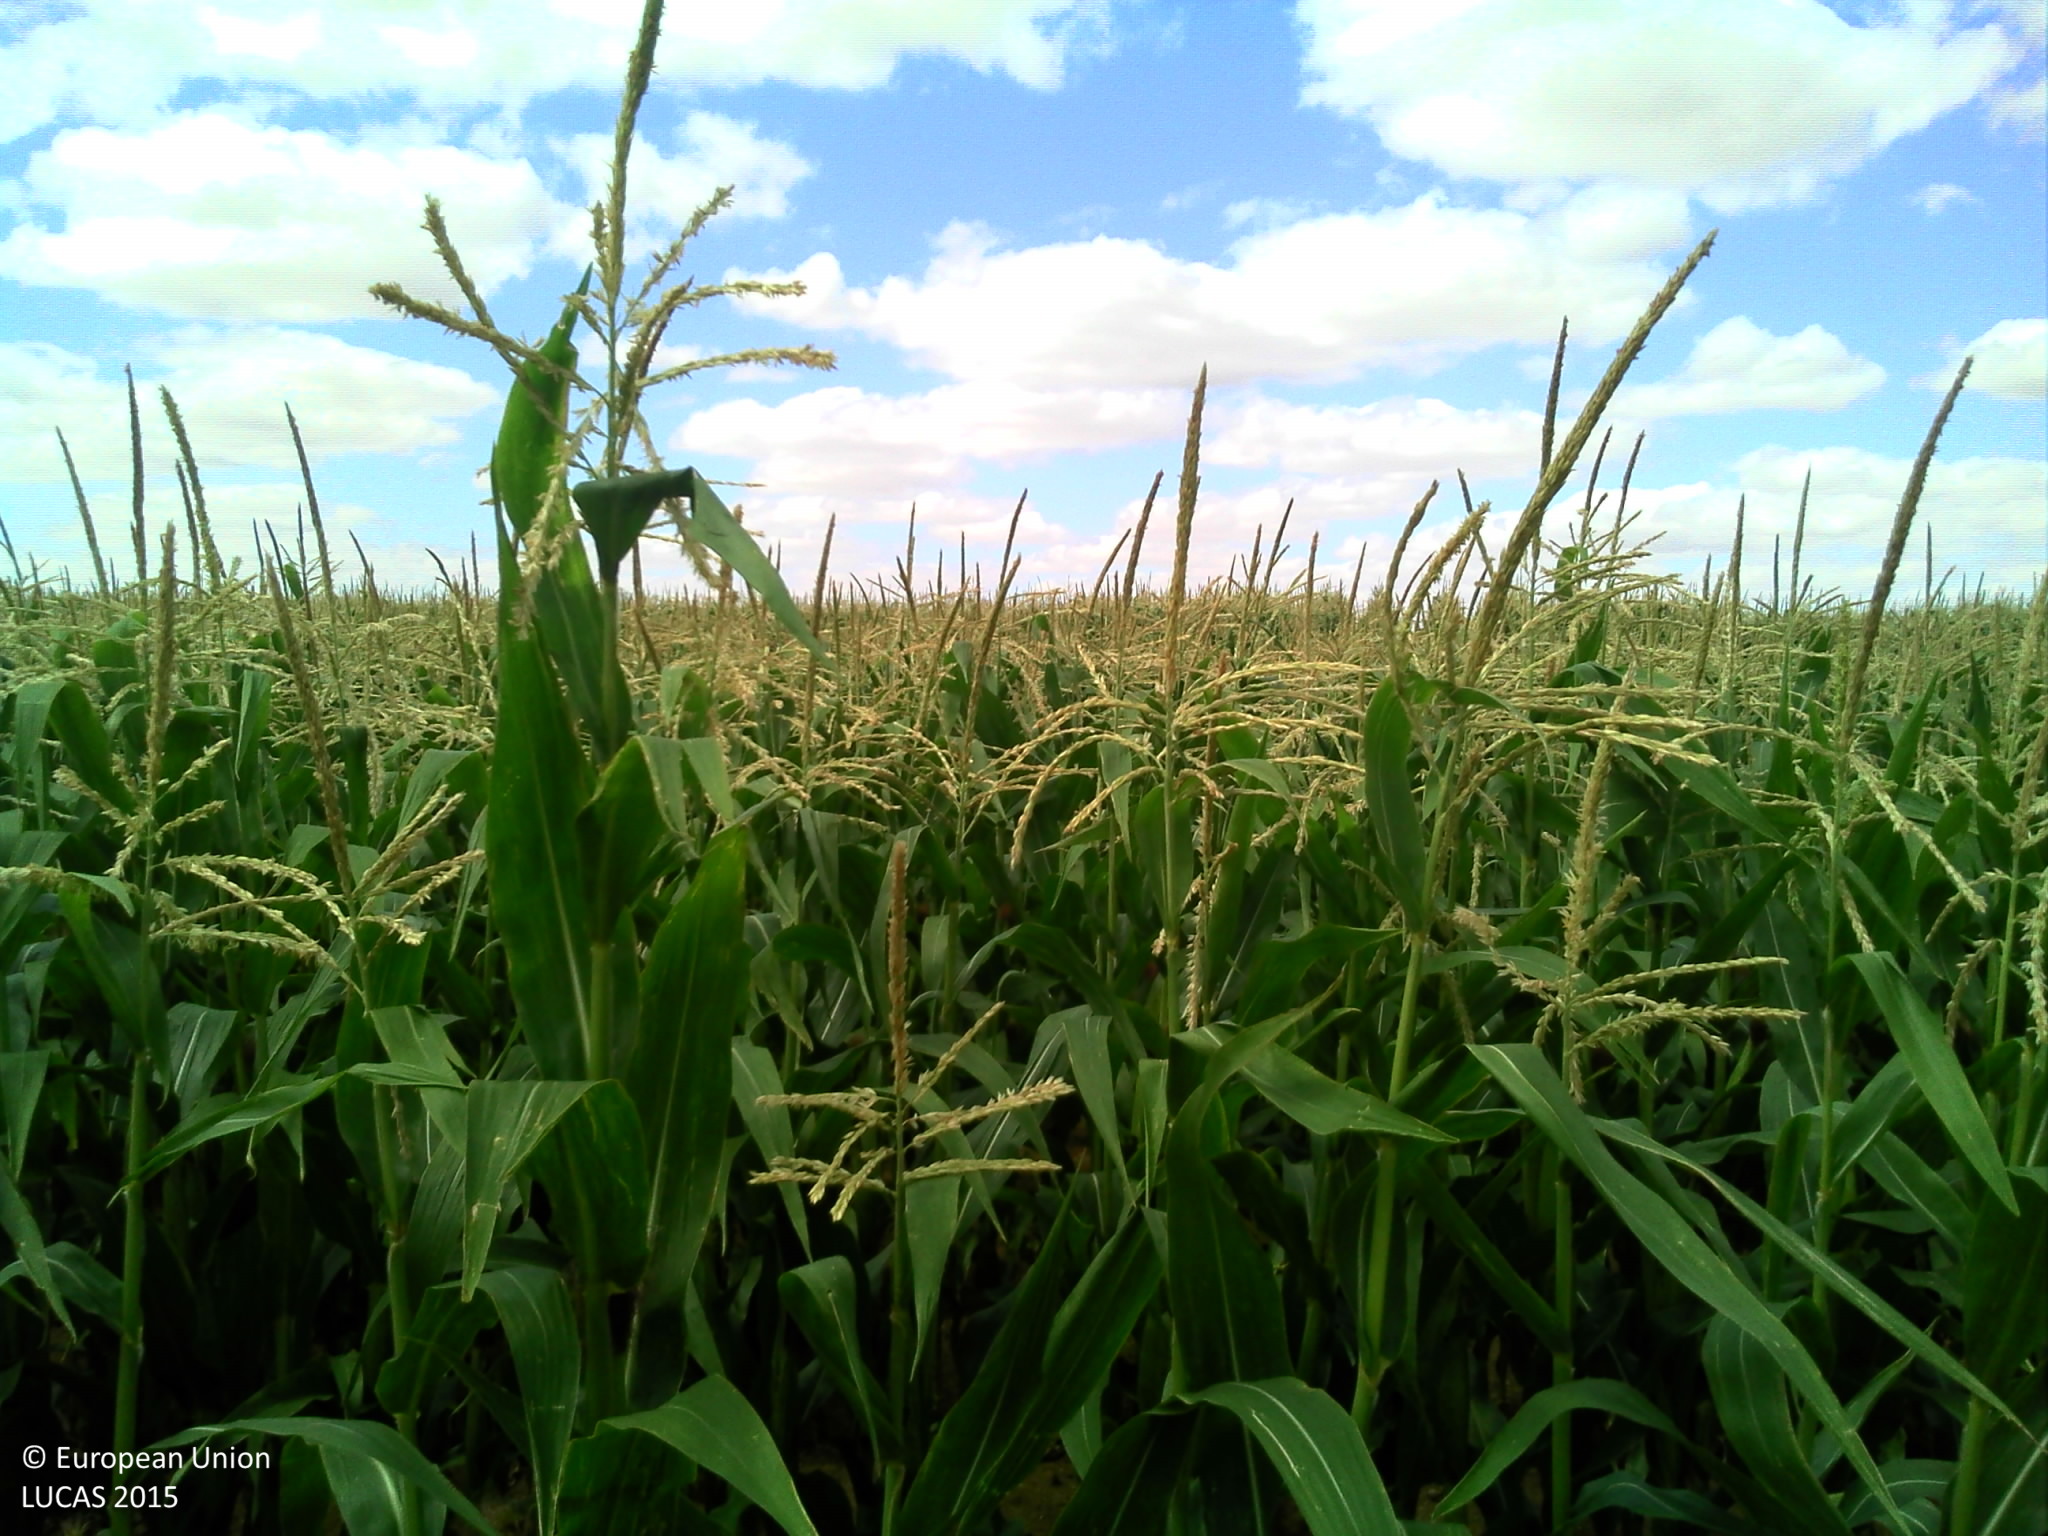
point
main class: Cropland
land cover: Maize
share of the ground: > 75 %
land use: Agriculture (excluding fallow land and kitchen gardens)
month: August
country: FR
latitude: 48.2202
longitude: 1.9784
